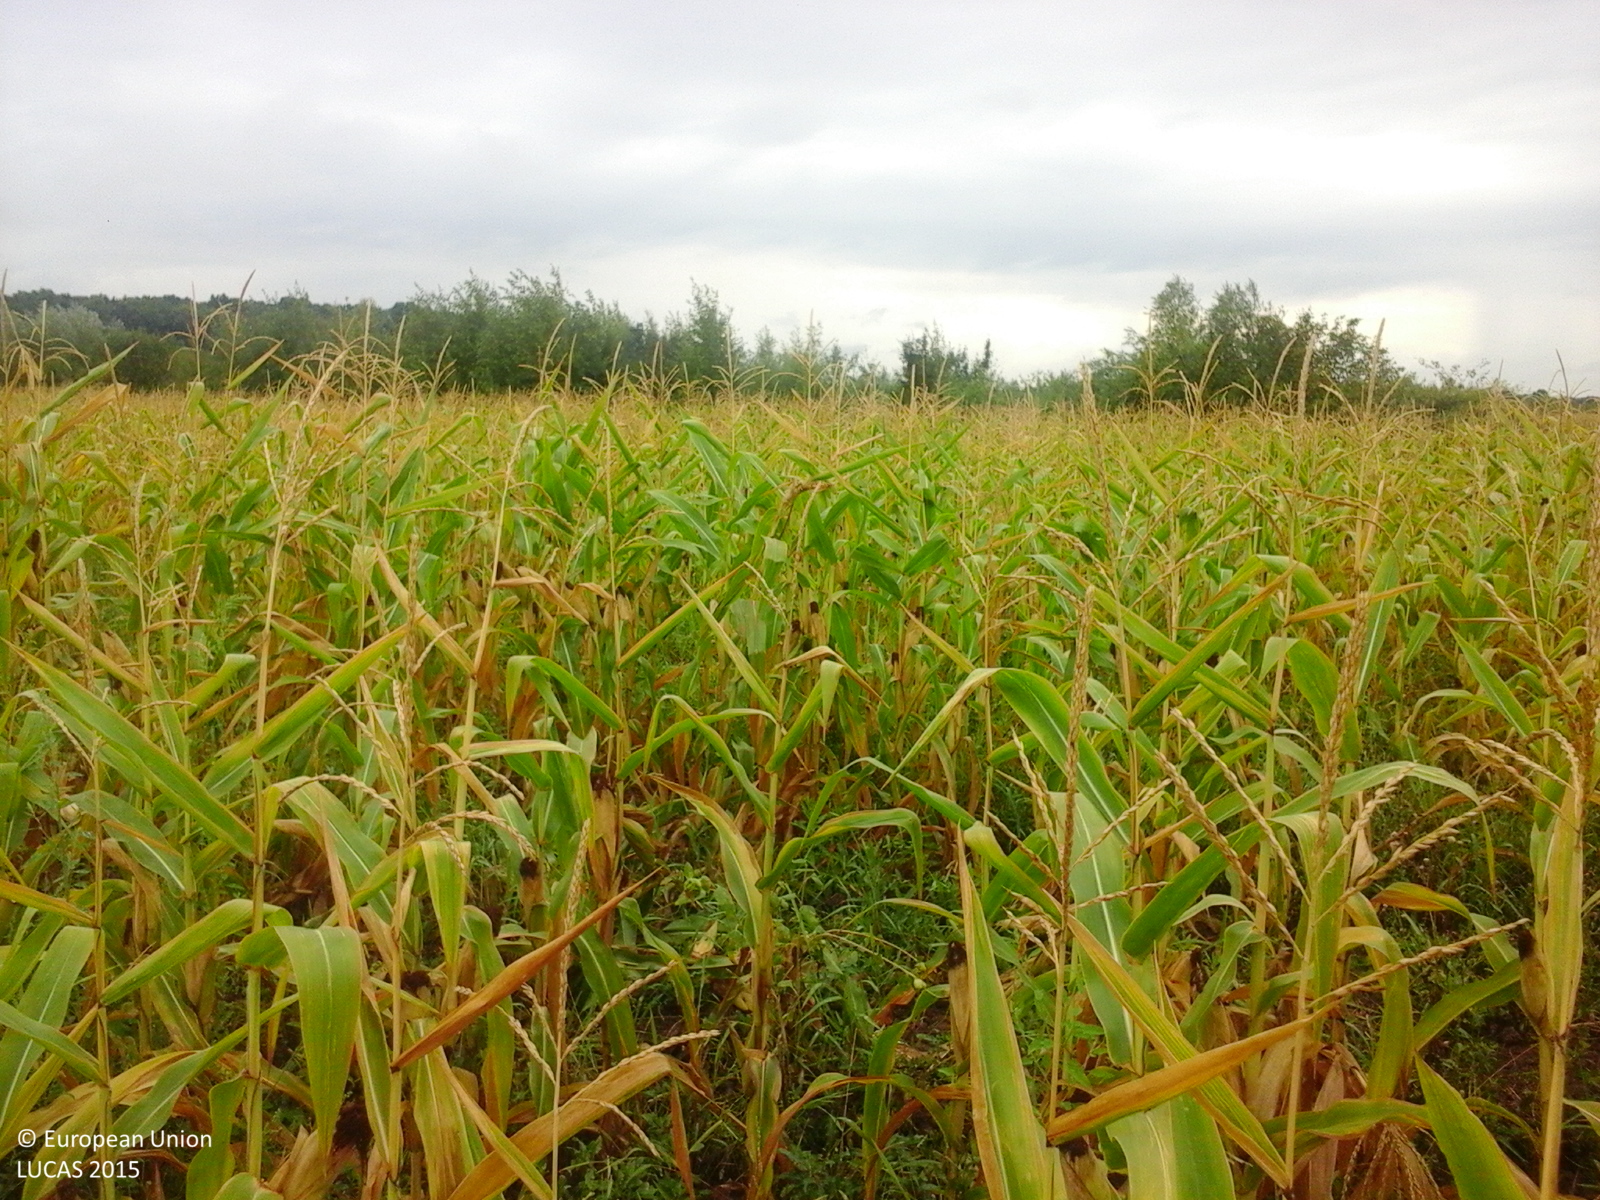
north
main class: Cropland
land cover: Maize
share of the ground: > 75 %
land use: Agriculture (excluding fallow land and kitchen gardens)
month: August
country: RO
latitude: 45.7621
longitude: 21.3595
